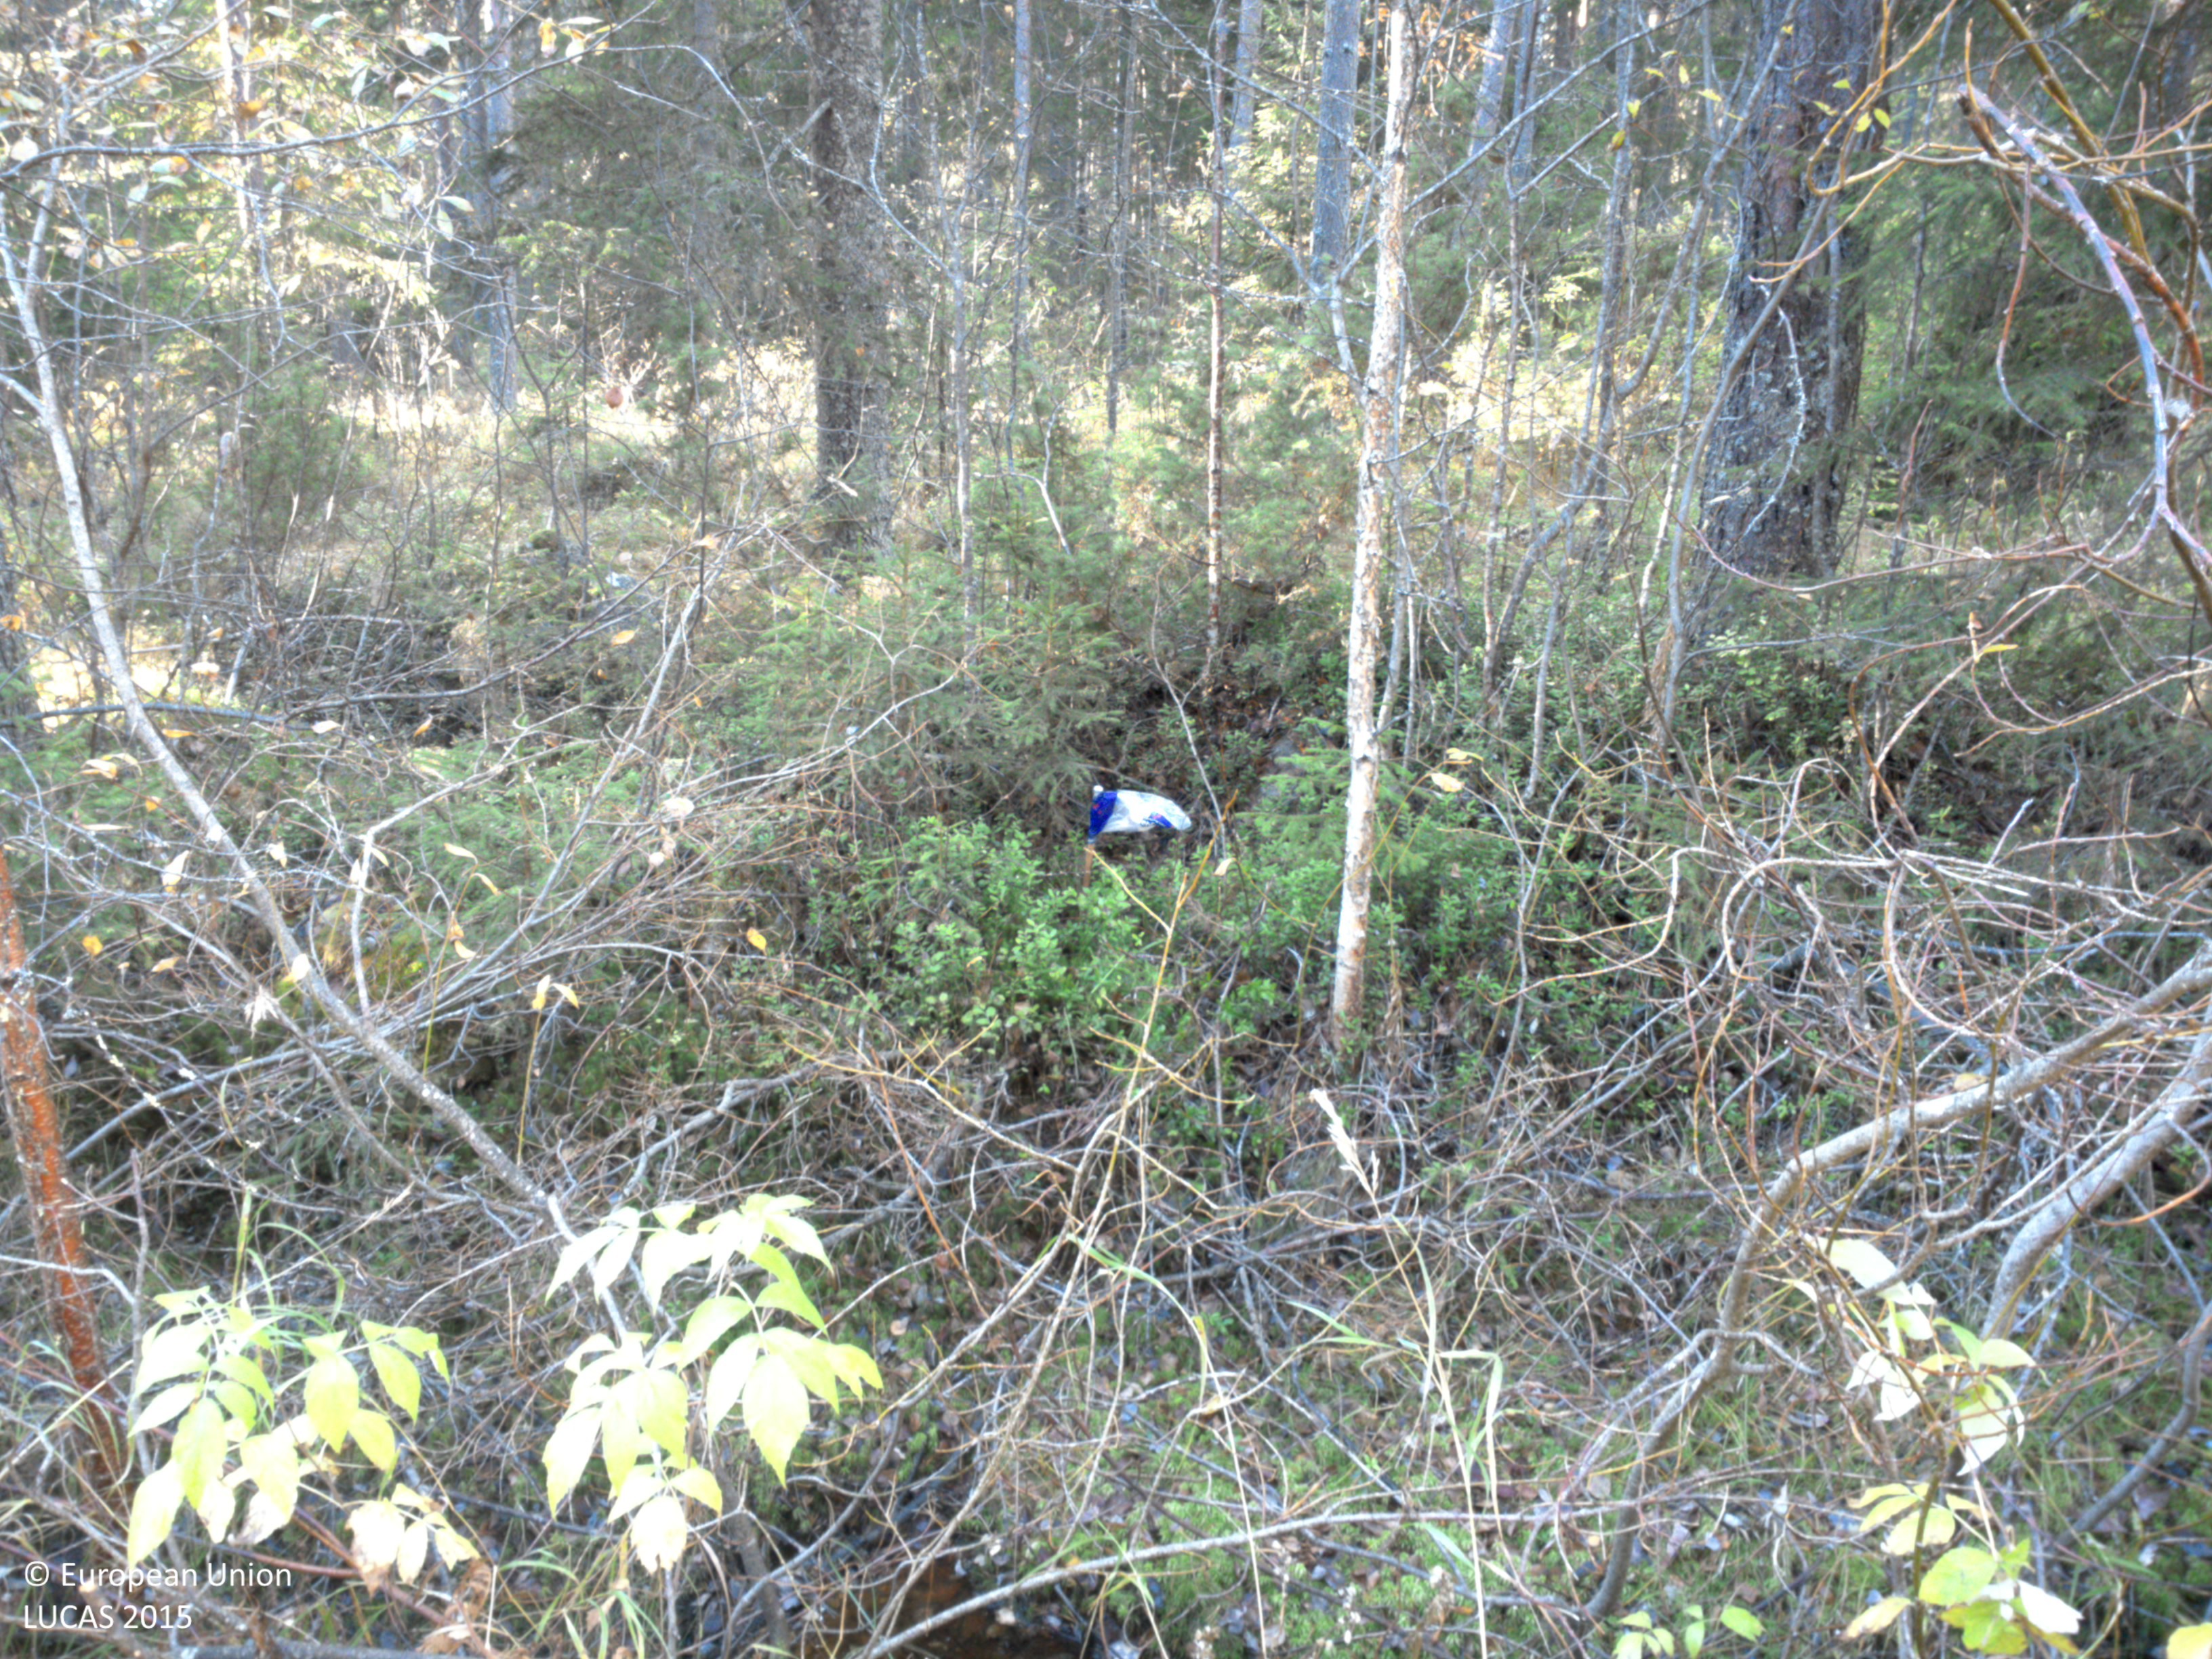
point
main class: Woodland
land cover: Other coniferous woodland
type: boreal forest
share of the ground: > 75 %
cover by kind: coniferous forest trees 80 %, shrubs 10 %, herbaceous plants 5 %, lichens and mosses 5 %
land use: Forestry
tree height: > 5 m
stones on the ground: 25 - 50 %
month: October
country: SE
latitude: 63.8747
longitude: 18.5835
